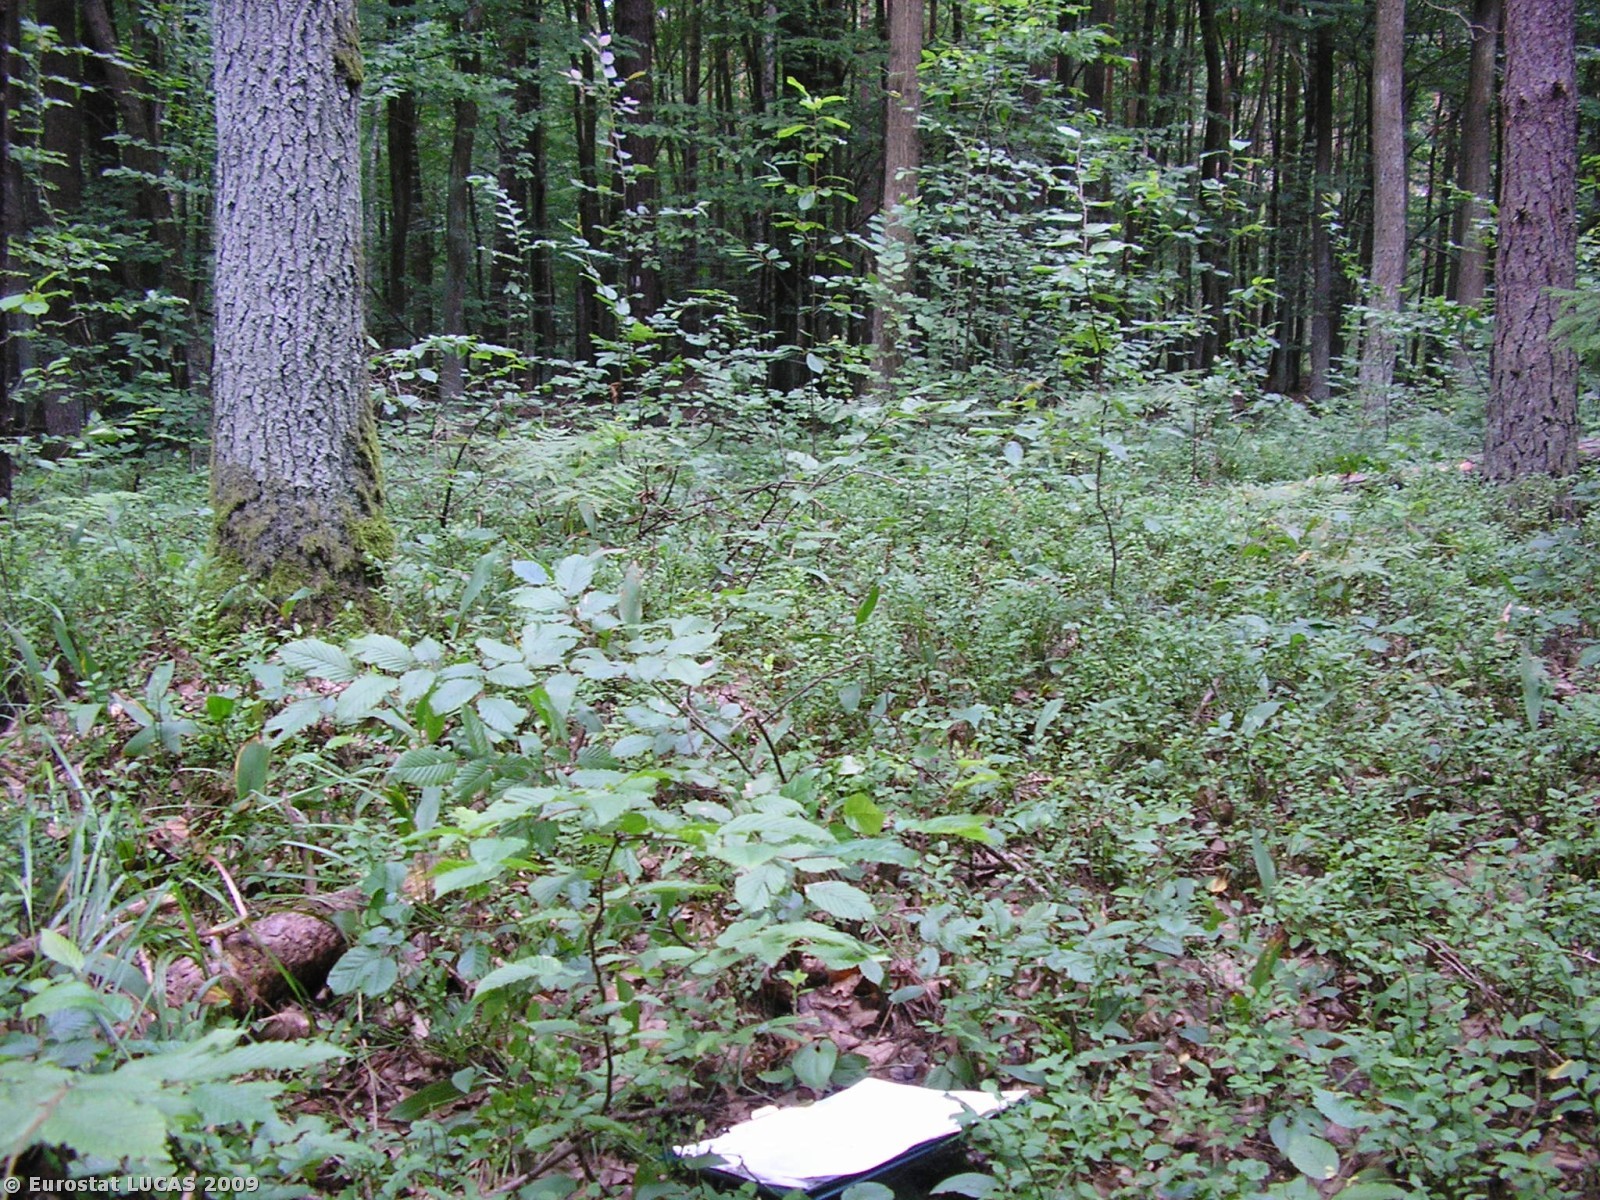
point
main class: Woodland
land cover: Mixed woodland
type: hemiboreal forest and nemoral coniferous forest and mixed broadleaved-coniferous forest
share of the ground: > 75 %
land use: Forestry
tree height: > 5 m
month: July
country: PL
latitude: 51.4922
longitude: 21.4724
